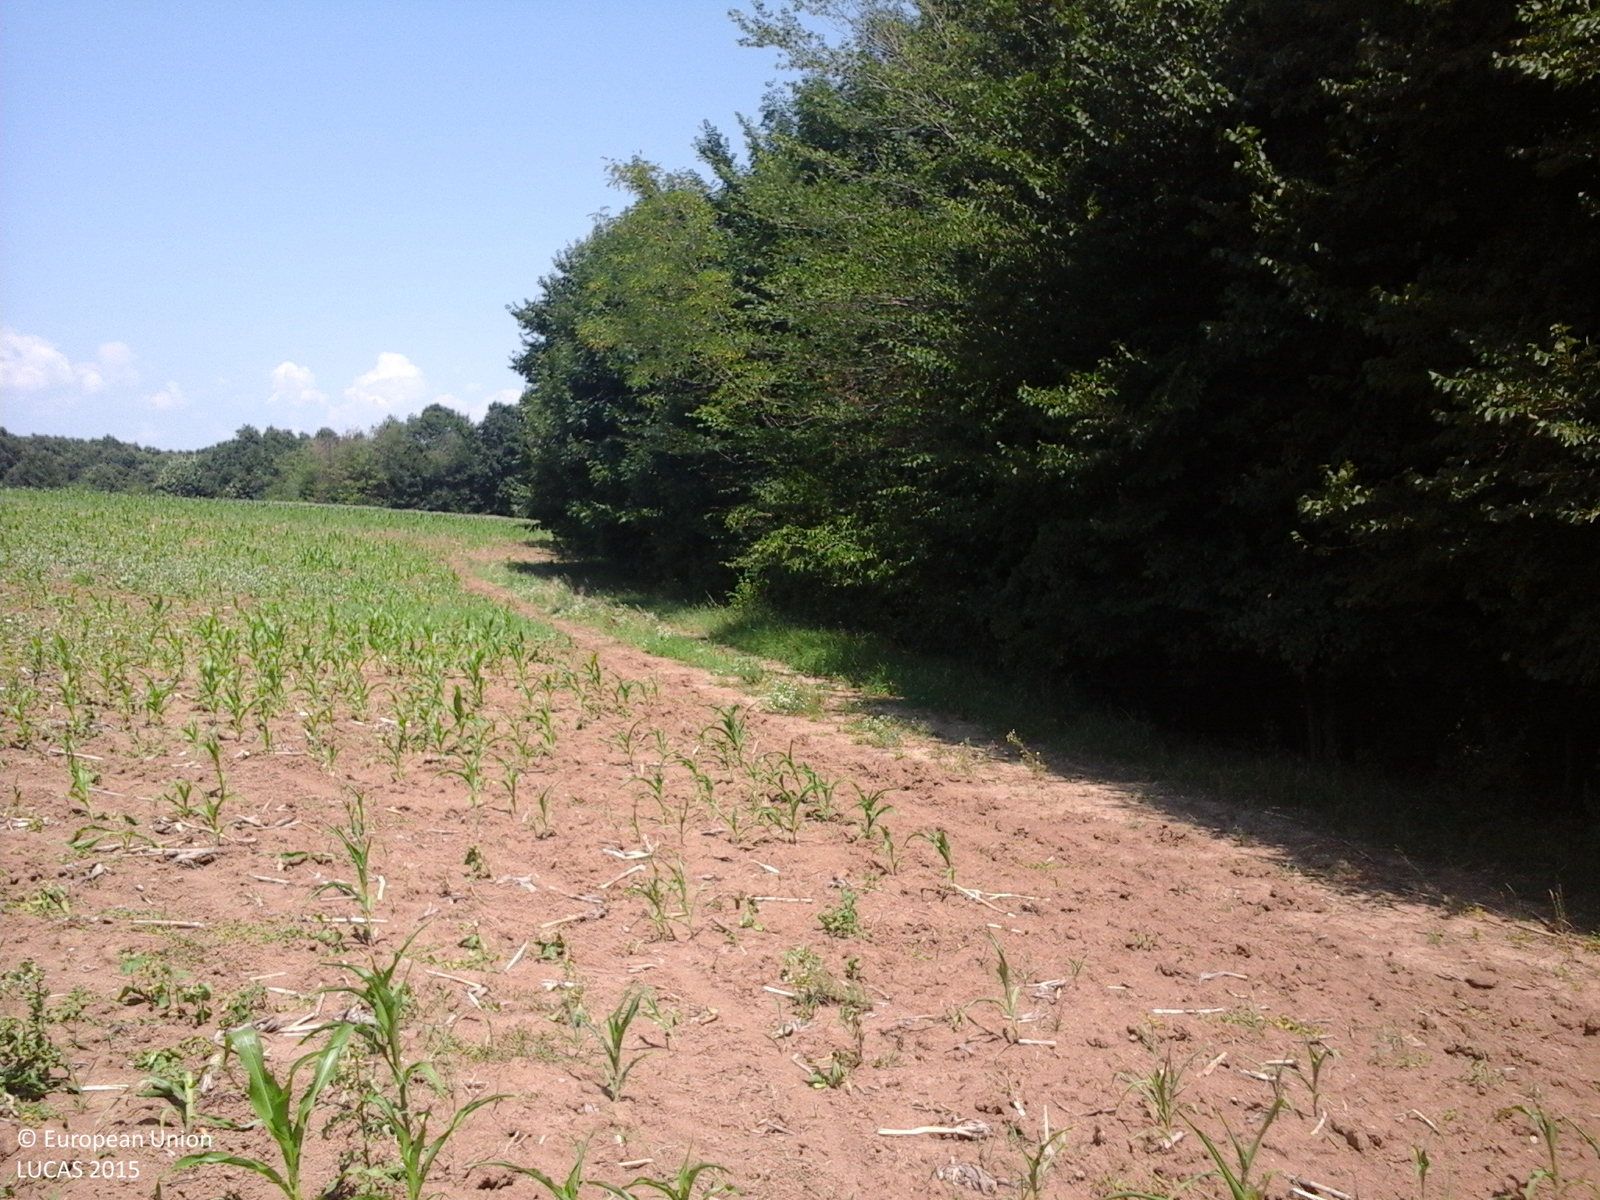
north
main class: Cropland
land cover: Maize
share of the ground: 10 - 25 %
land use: Agriculture (excluding fallow land and kitchen gardens)
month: July
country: RO
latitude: 44.8715
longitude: 24.5686
